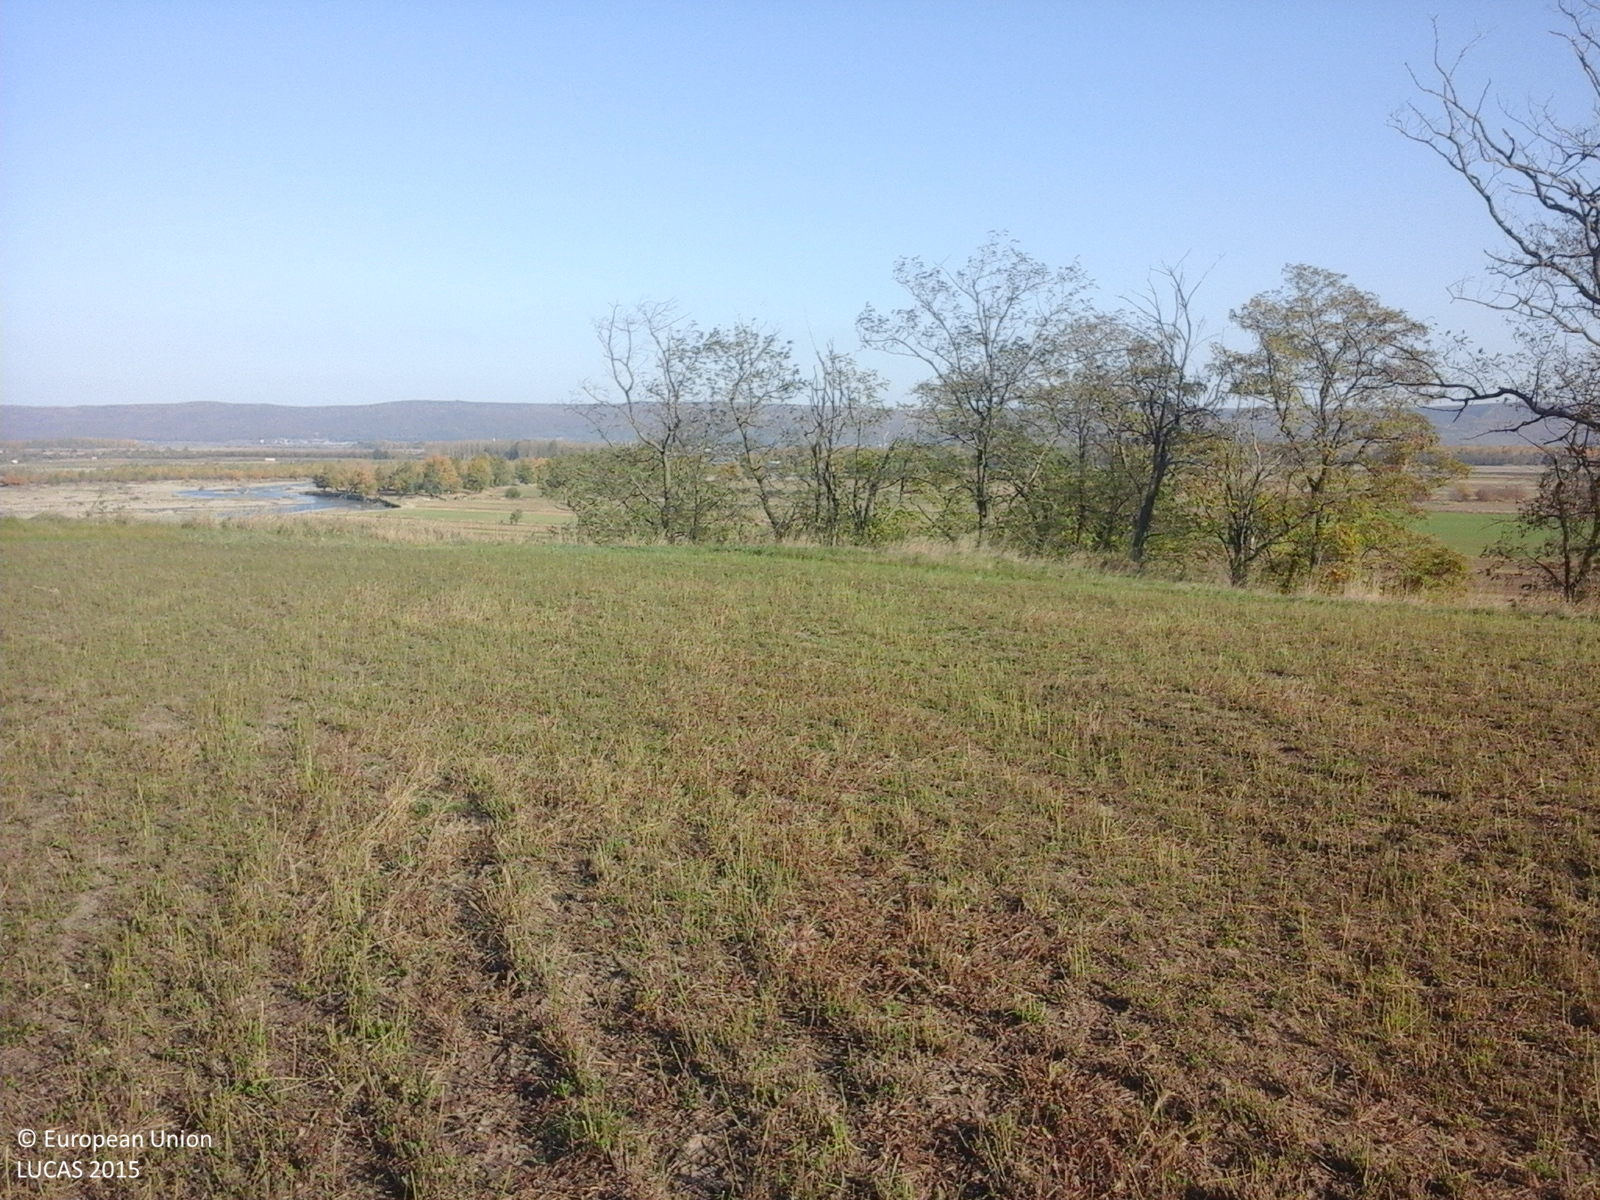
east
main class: Cropland
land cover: Lucerne
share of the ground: 50 - 75 %
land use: Agriculture (excluding fallow land and kitchen gardens)
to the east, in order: Lucerne; Broadleaved woodland; Grassland without tree/shrub cover; Tracks; Spontaneously vegetated surfaces; Lines of trees; Grass margins; Paved roads, cycling and walking lanes; Grass margins; Lines of trees; Grass margins
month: October
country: RO
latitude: 46.0706
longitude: 27.1767
